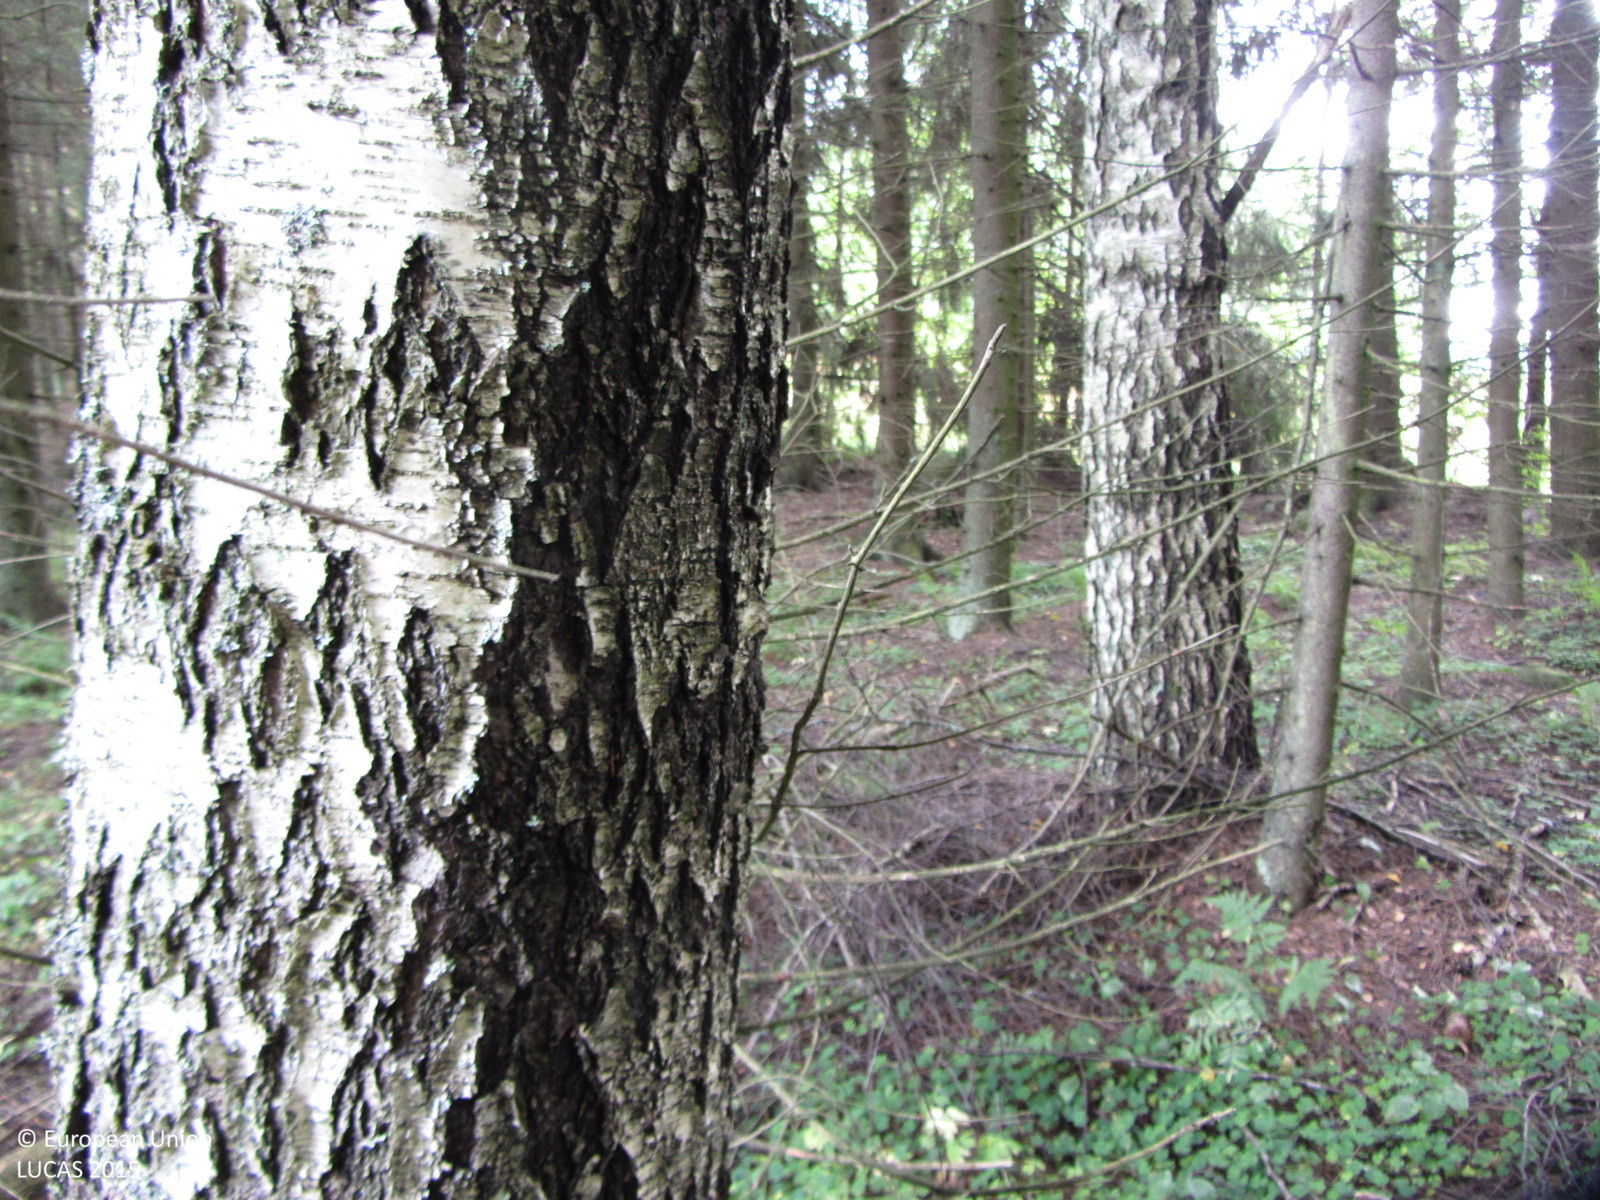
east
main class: Woodland
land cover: Spruce dominated mixed woodland
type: boreal forest
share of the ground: > 75 %
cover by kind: coniferous forest trees 65 %, broadleaved forest trees 25 %, herbaceous plants 10 %
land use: Forestry
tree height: > 5 m
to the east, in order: Spruce dominated mixed woodland; Other non-permanent industrial crops; Ditches and canals; Grass margins; Paved roads, cycling and walking lanes; Grass margins; Other mixed woodland; Broadleaved woodland
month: July
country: FI
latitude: 60.5613
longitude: 24.1619
